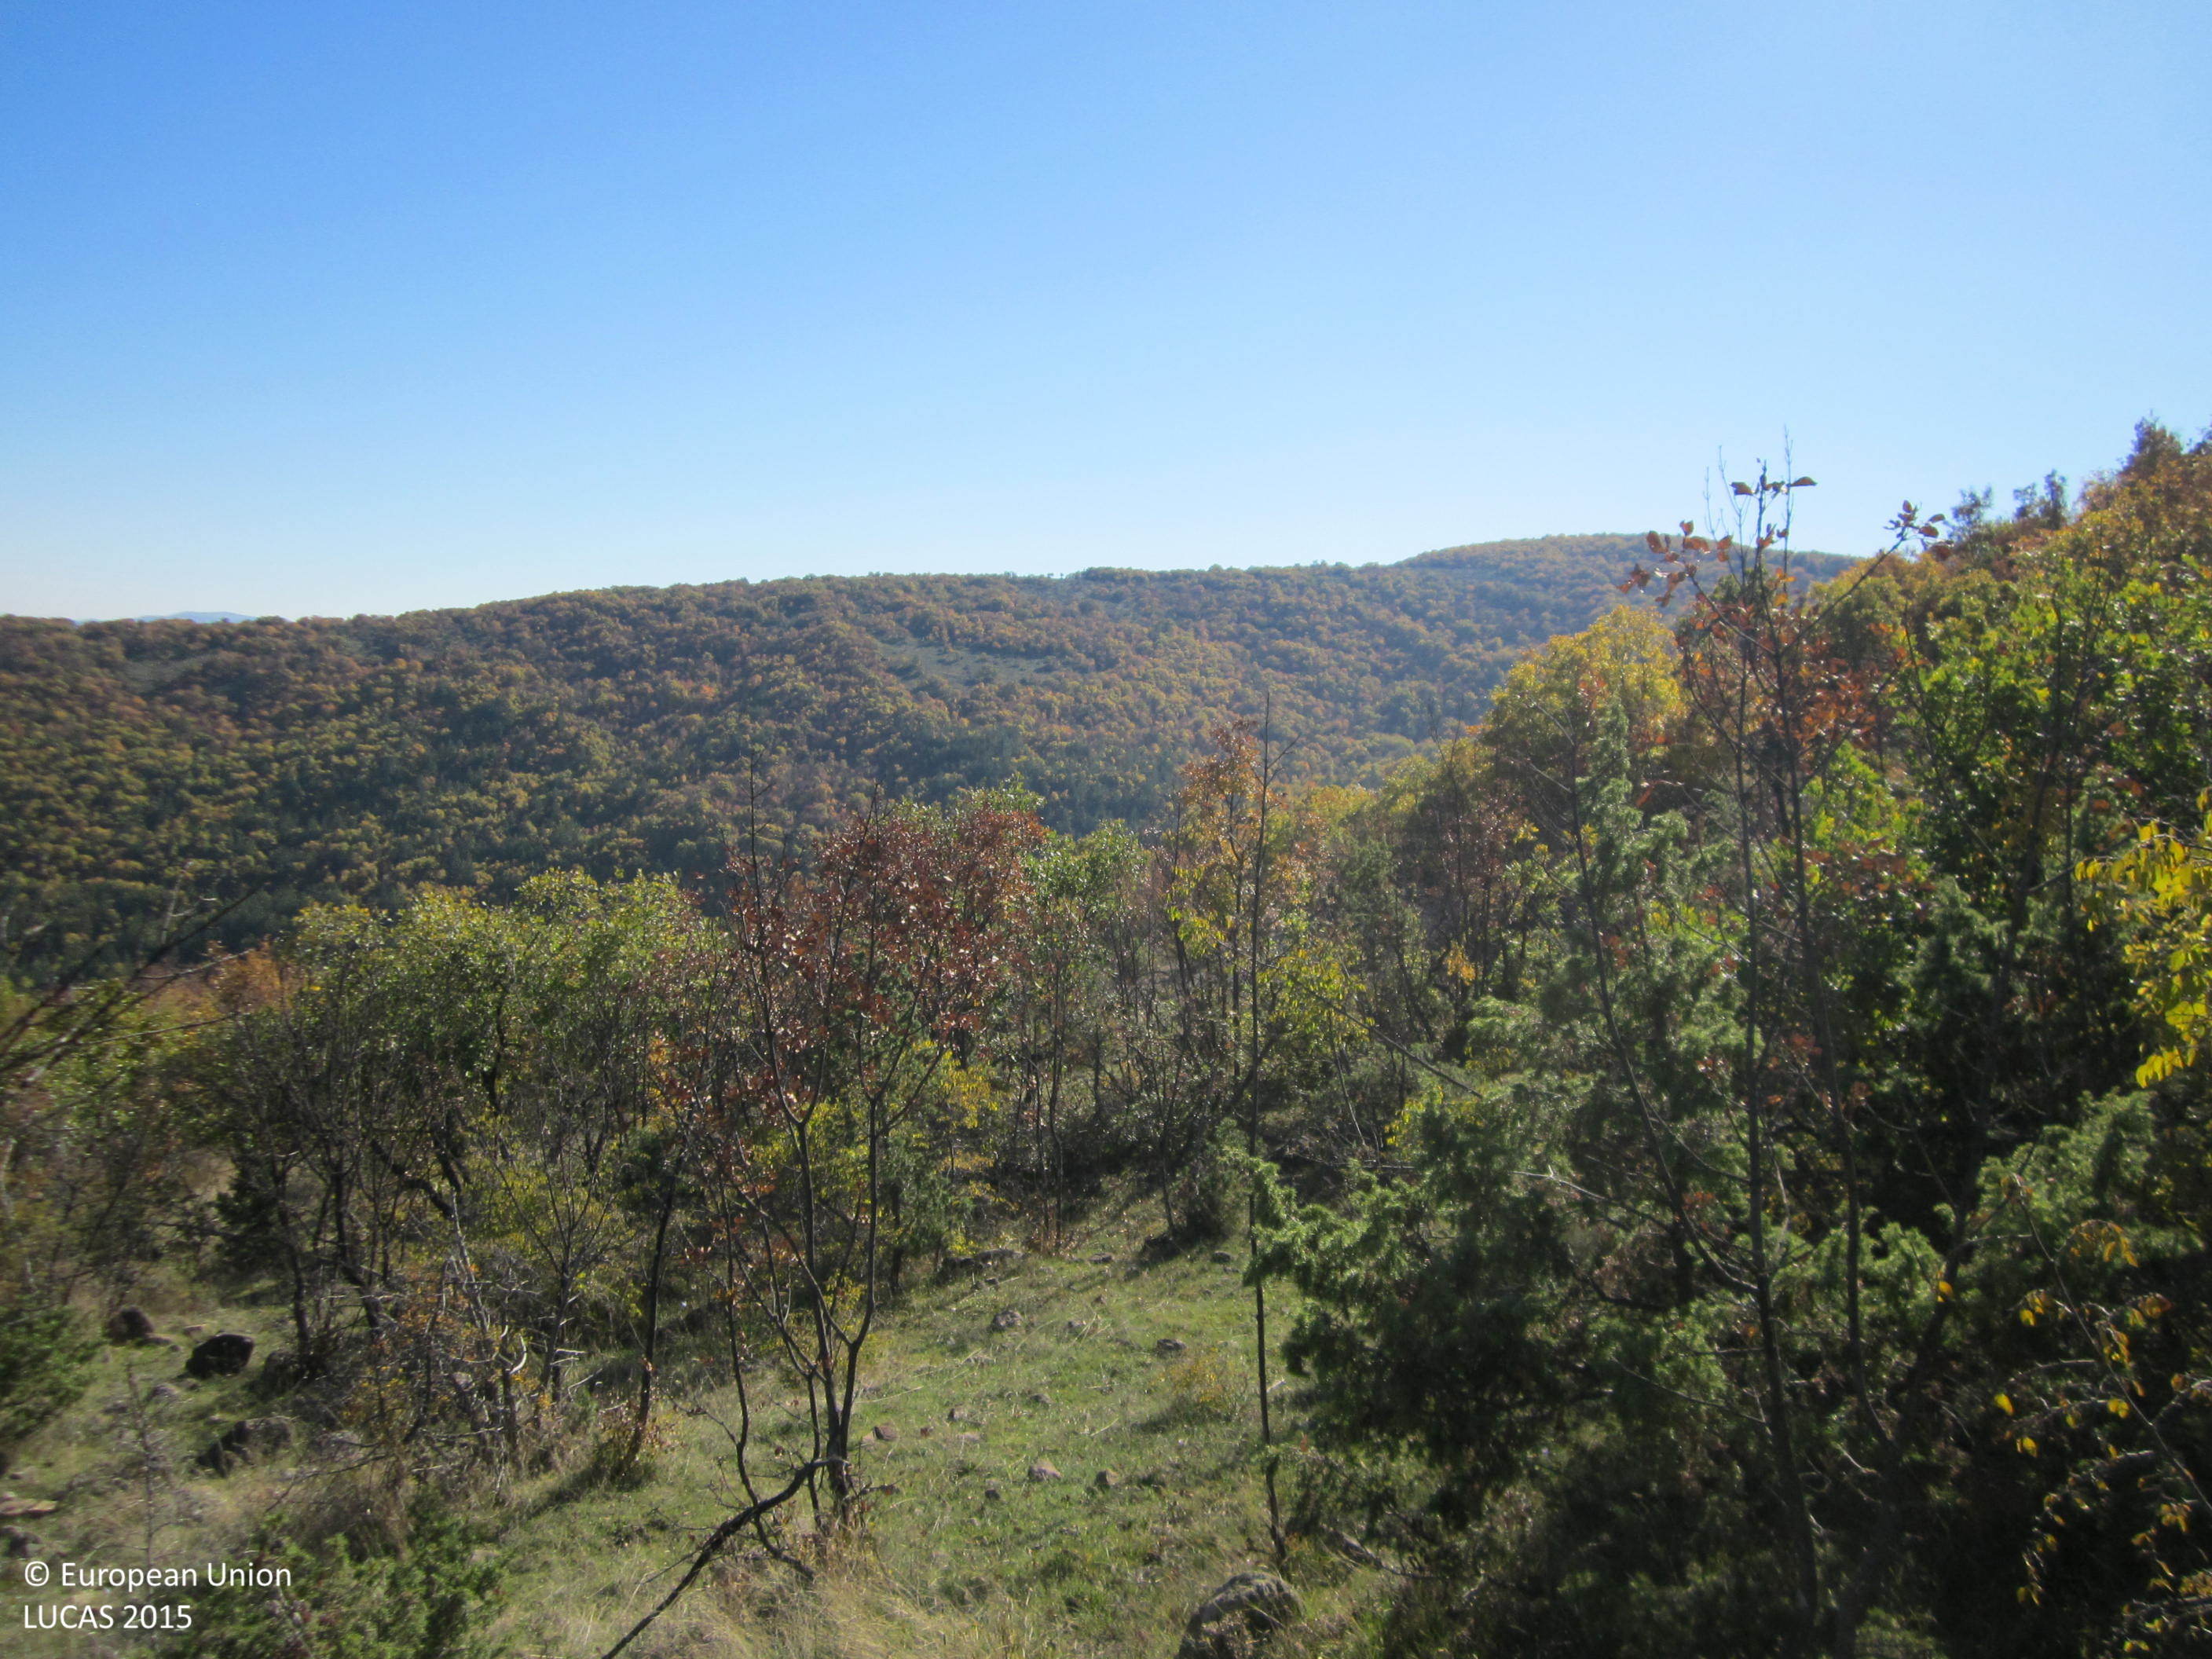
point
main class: Woodland
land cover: Broadleaved woodland
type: mesophytic deciduous forest
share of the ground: > 75 %
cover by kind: broadleaved forest trees 100 %
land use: Forestry
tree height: > 5 m
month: November
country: BG
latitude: 41.5845
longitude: 25.5941
